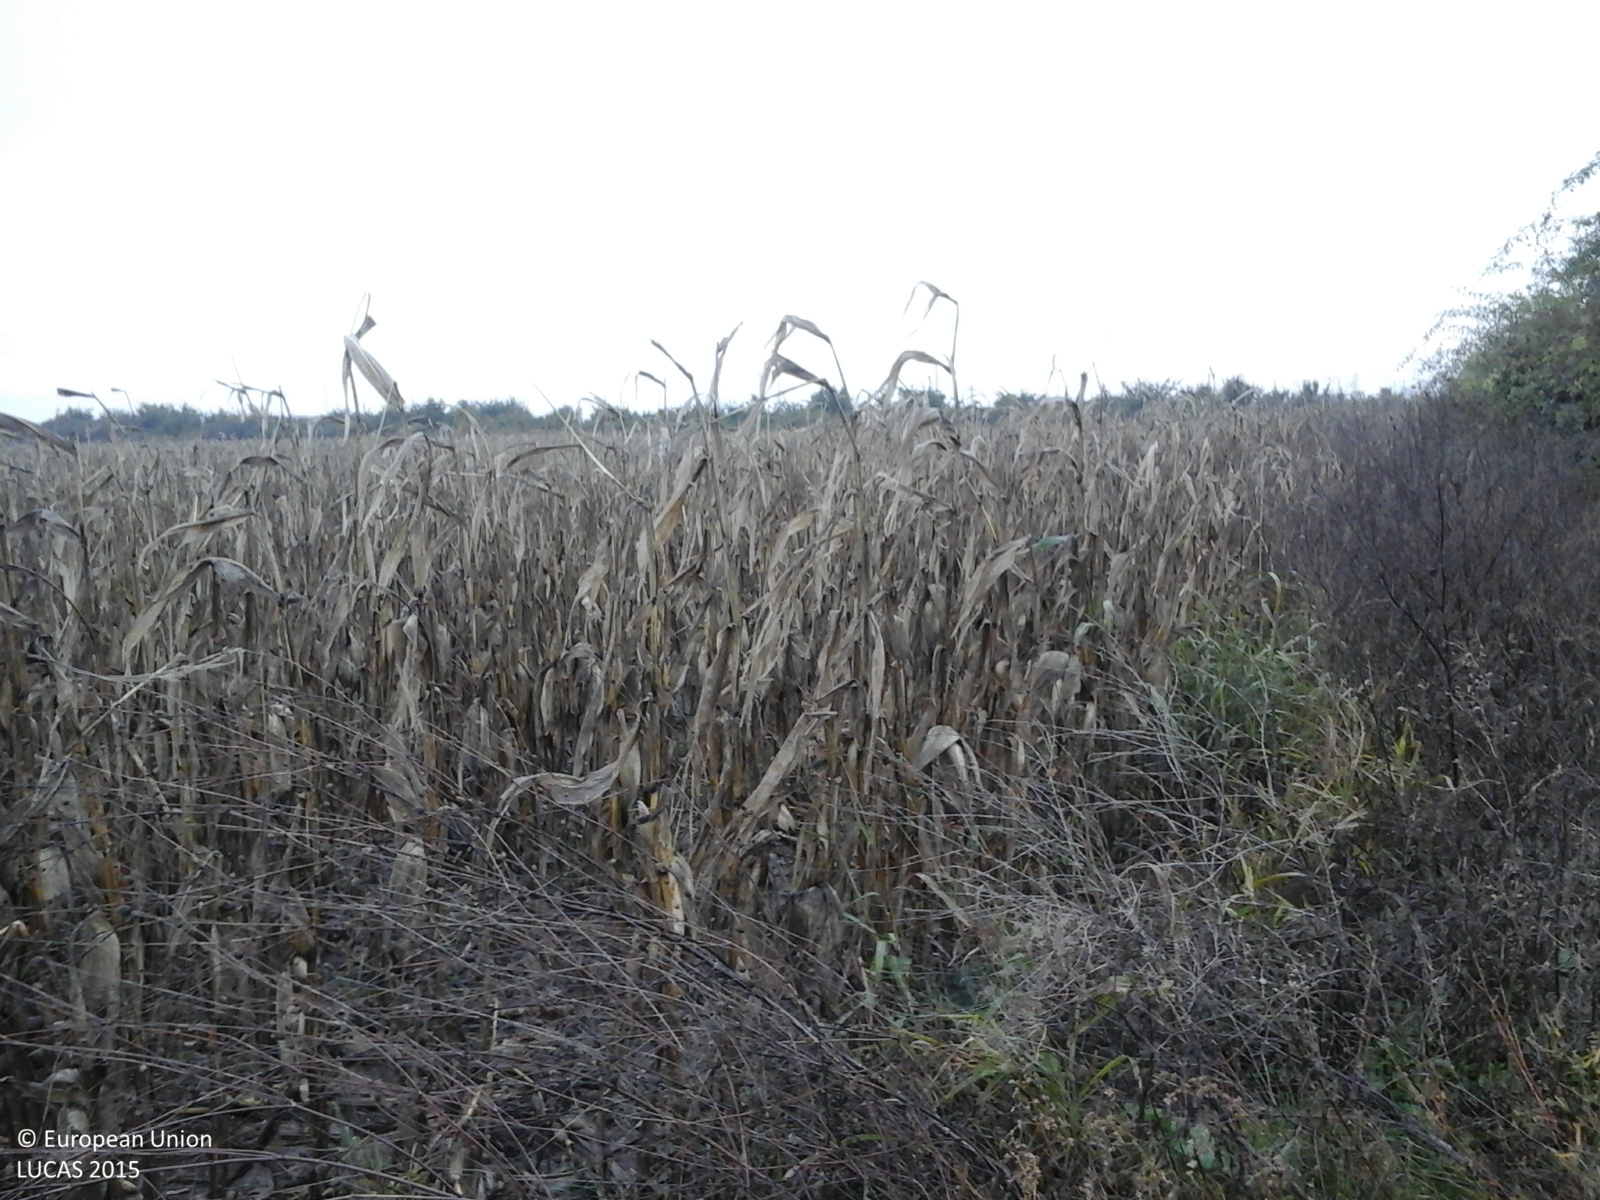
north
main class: Cropland
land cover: Maize
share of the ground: > 75 %
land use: Agriculture (excluding fallow land and kitchen gardens)
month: October
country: RO
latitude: 44.8418
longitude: 26.0094
